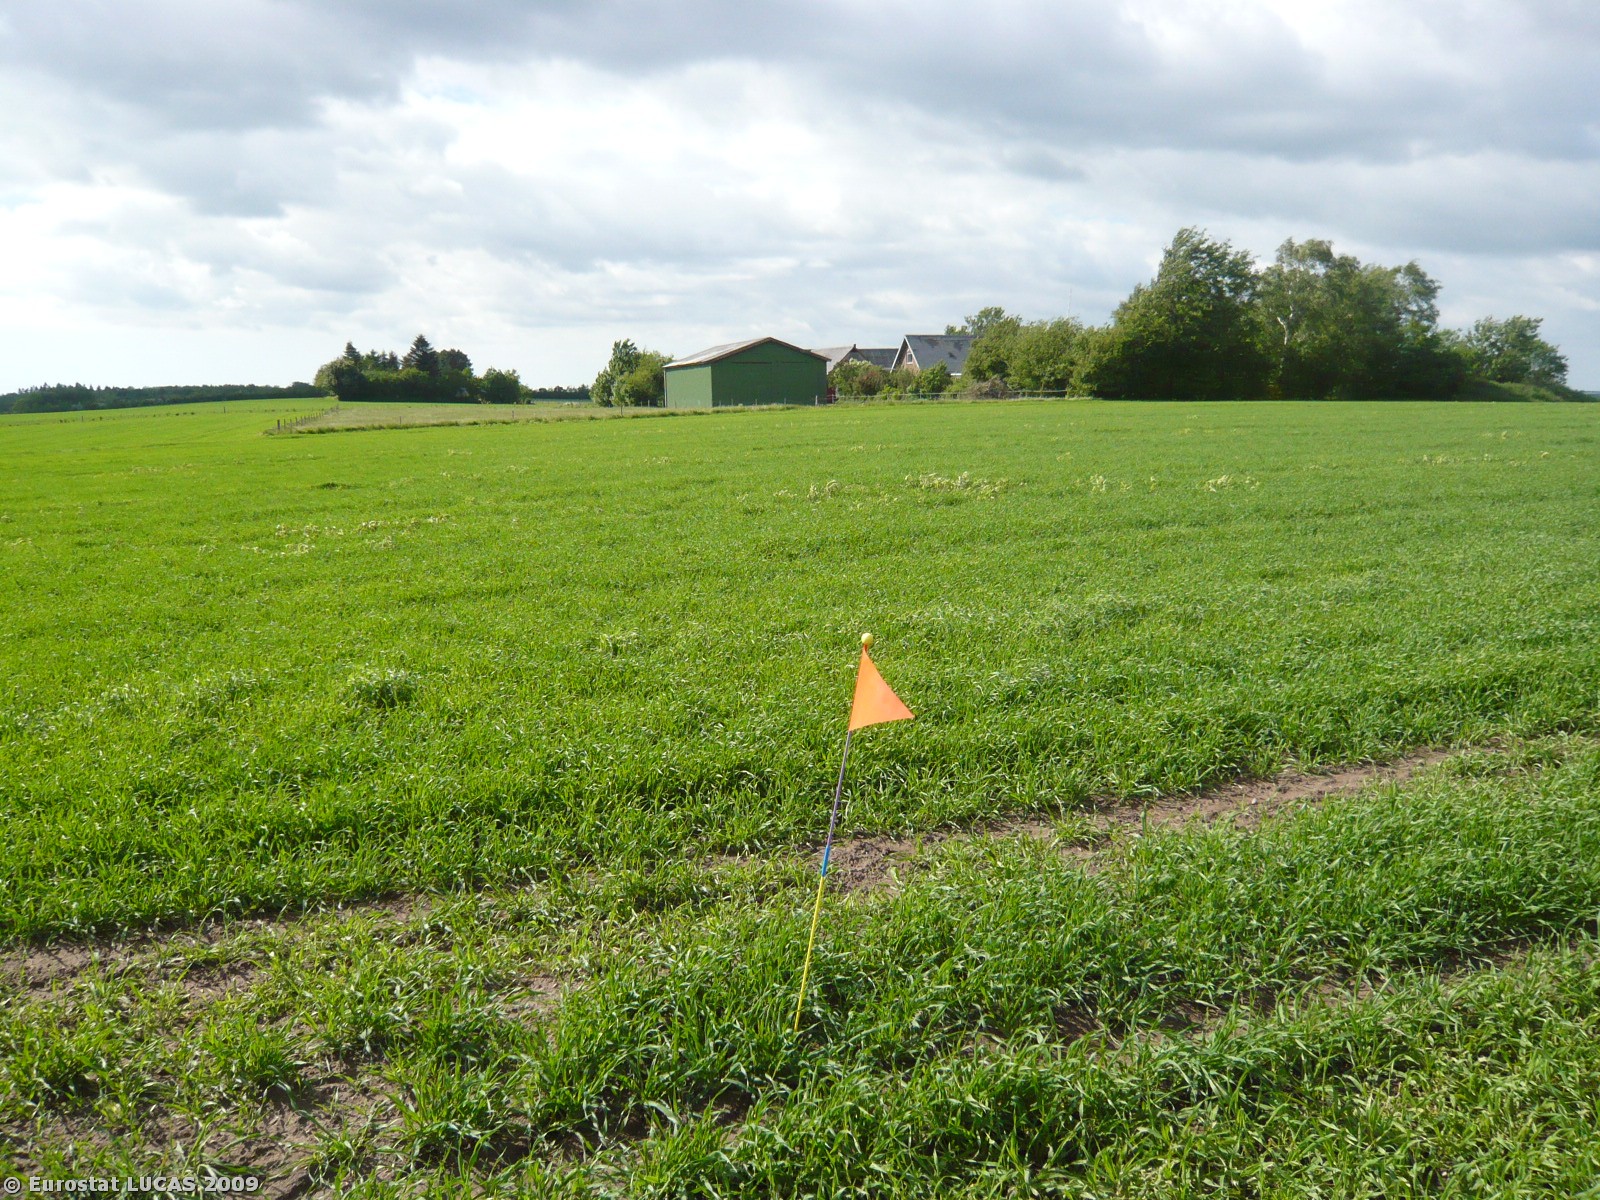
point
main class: Cropland
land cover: Barley
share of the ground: > 75 %
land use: Agriculture (excluding fallow land and kitchen gardens)
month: May
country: DK
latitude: 55.3676
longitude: 11.6868
